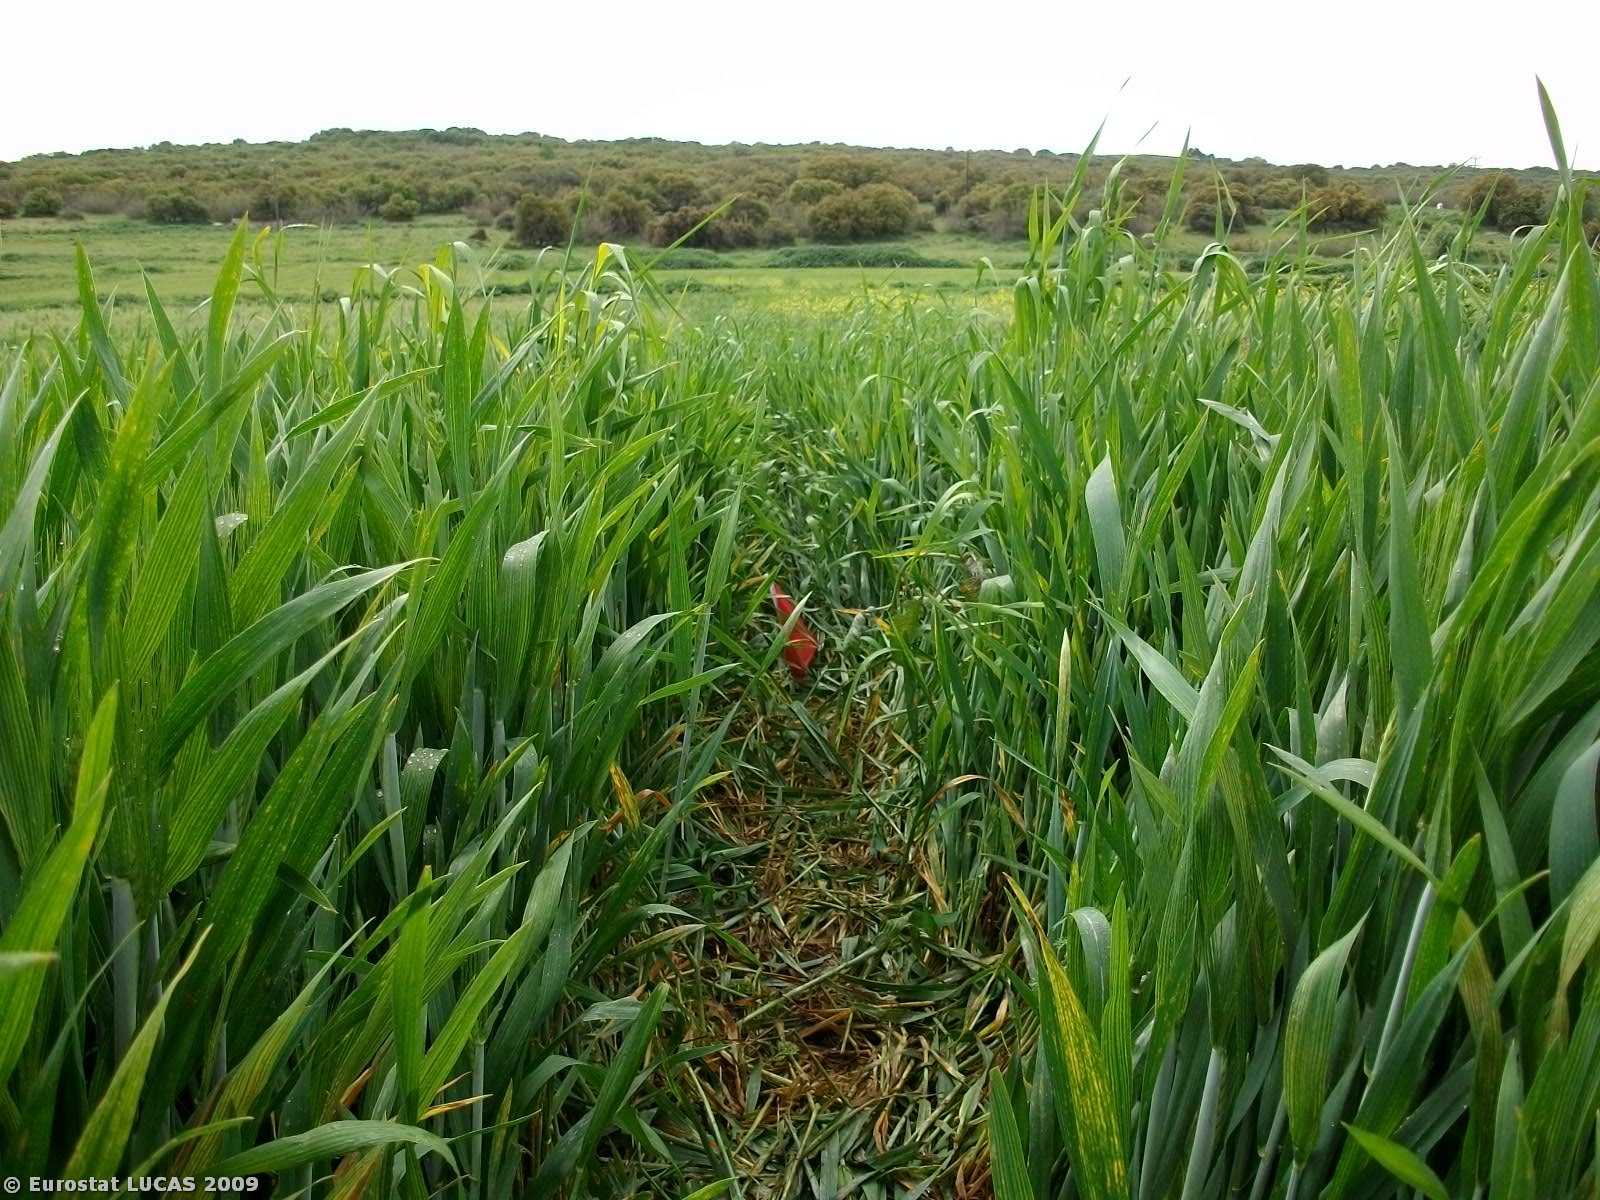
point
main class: Cropland
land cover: Durum wheat
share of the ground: > 75 %
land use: Agriculture (excluding fallow land and kitchen gardens)
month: April
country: GR
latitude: 39.4457
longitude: 22.3621
